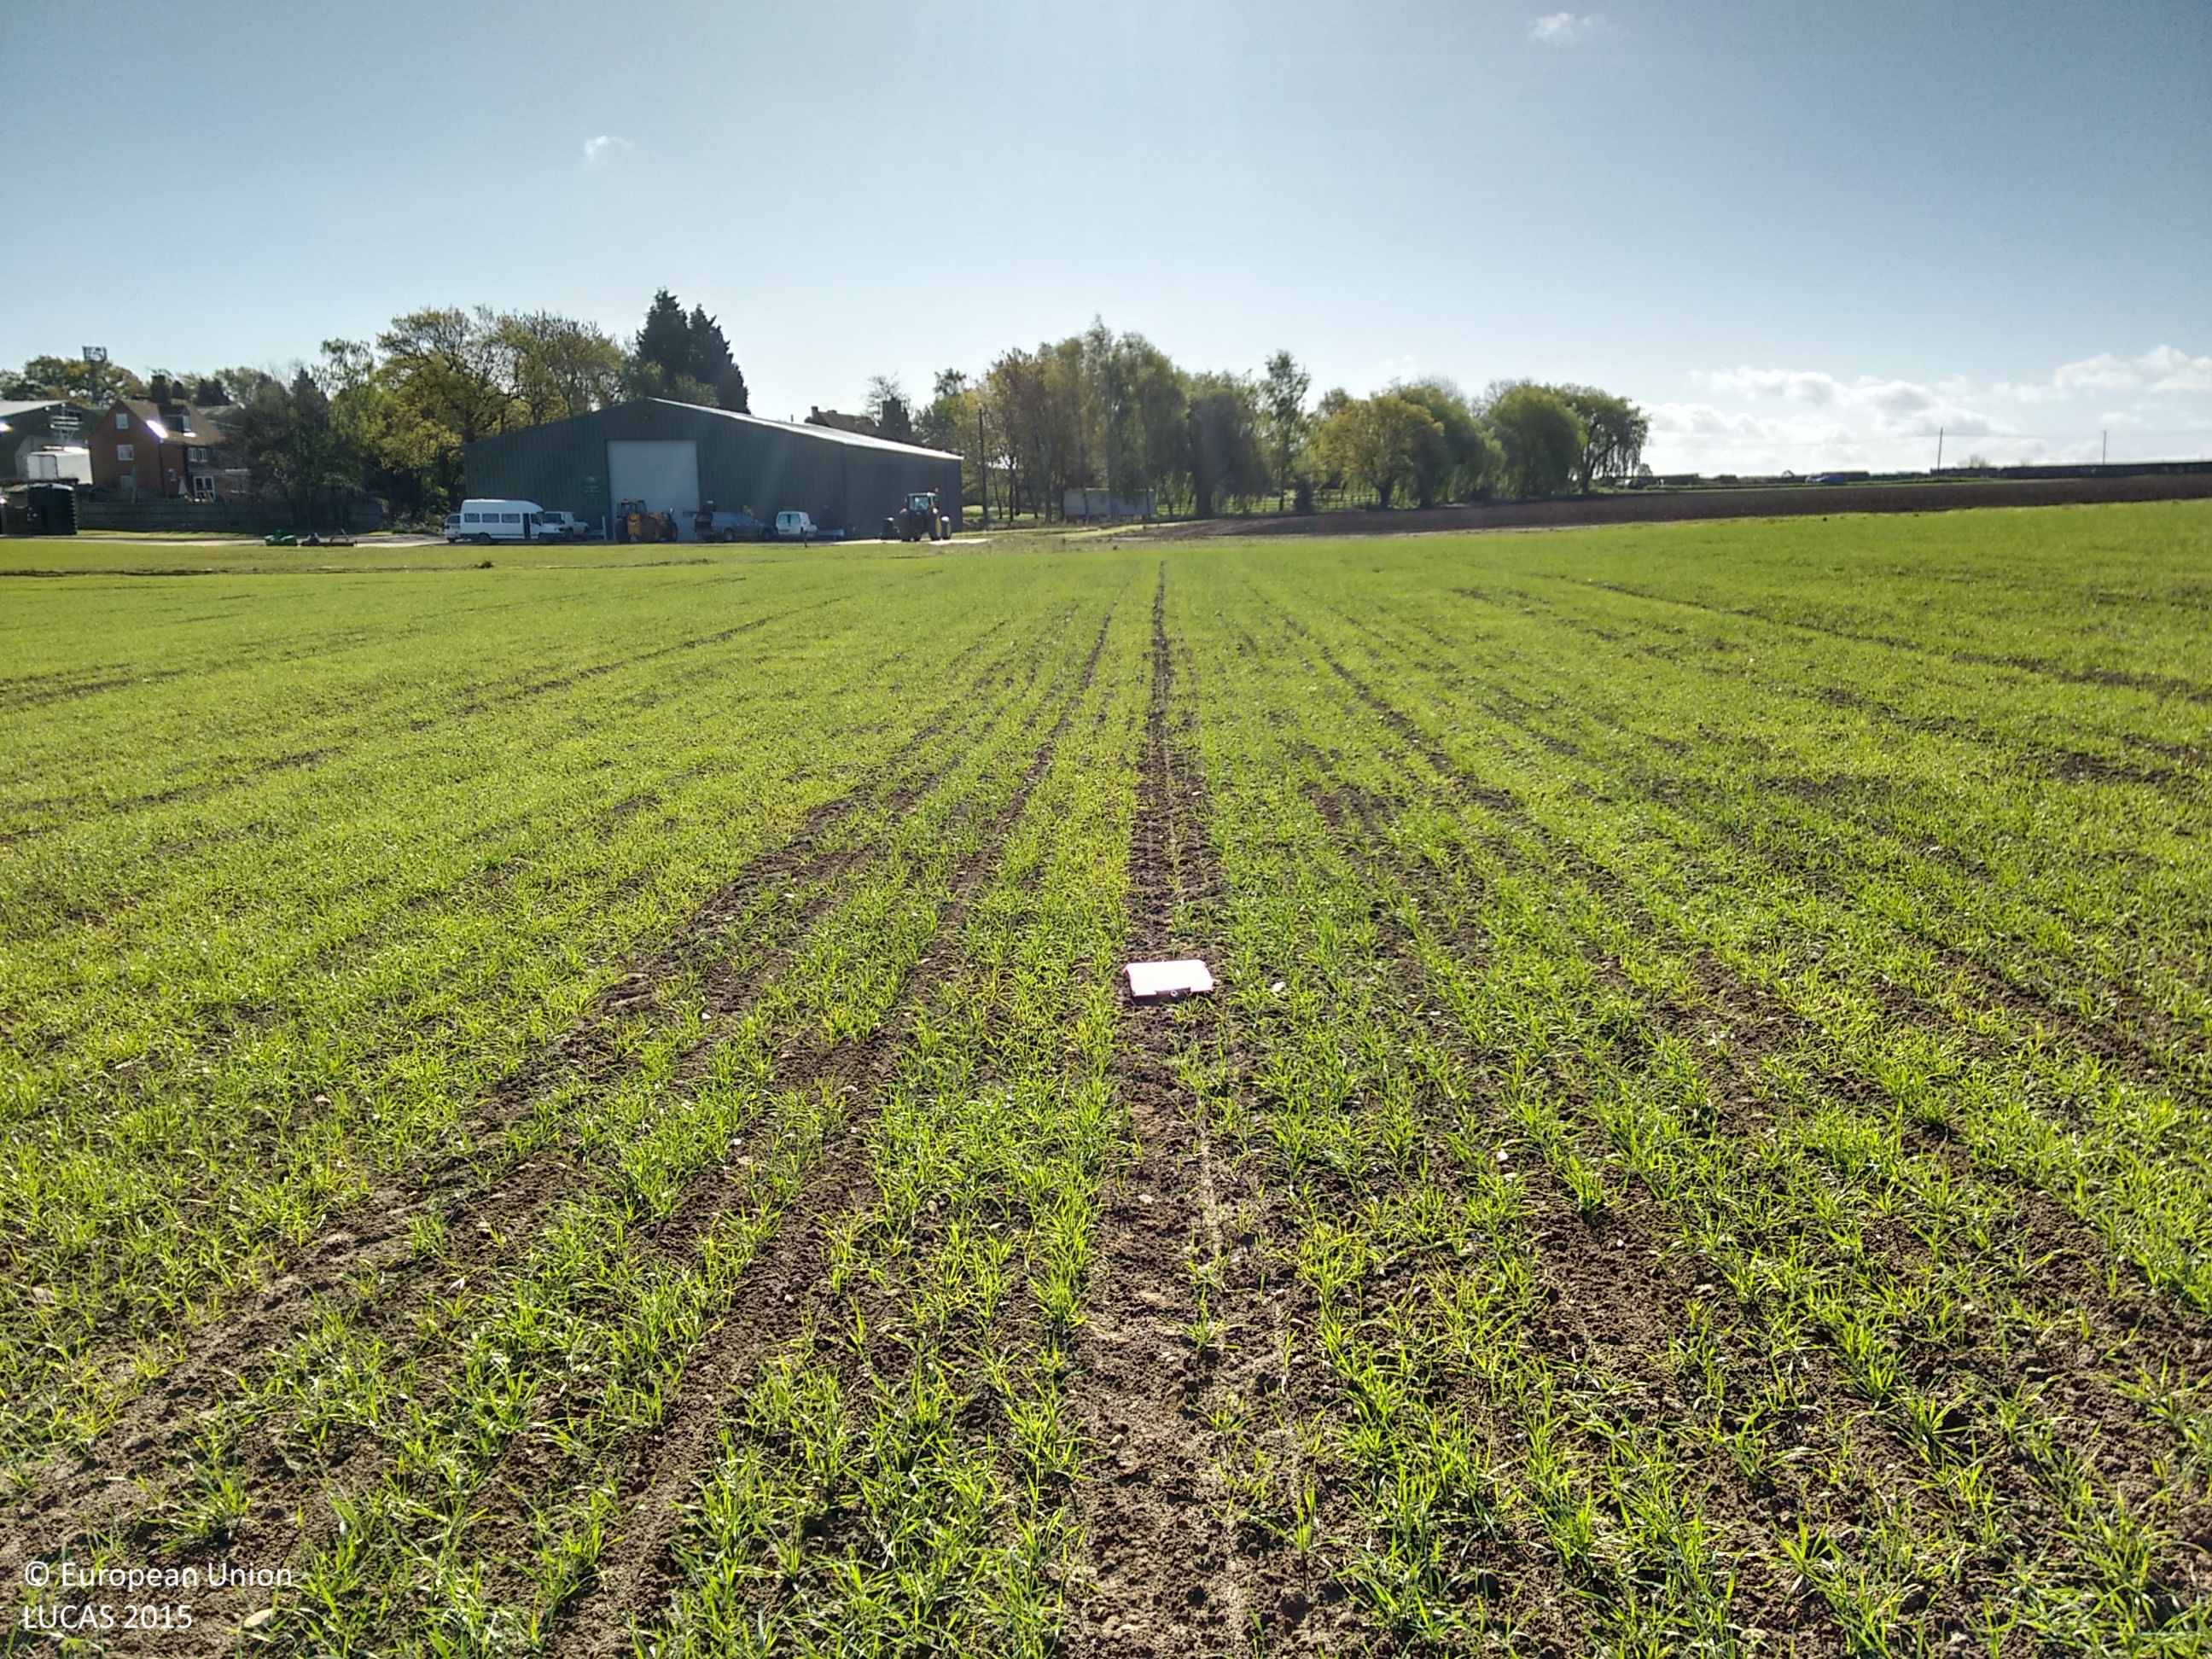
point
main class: Cropland
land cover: Common wheat
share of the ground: 25 - 50 %
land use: Agriculture (excluding fallow land and kitchen gardens)
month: April
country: GB
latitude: 51.2975
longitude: 0.3762
